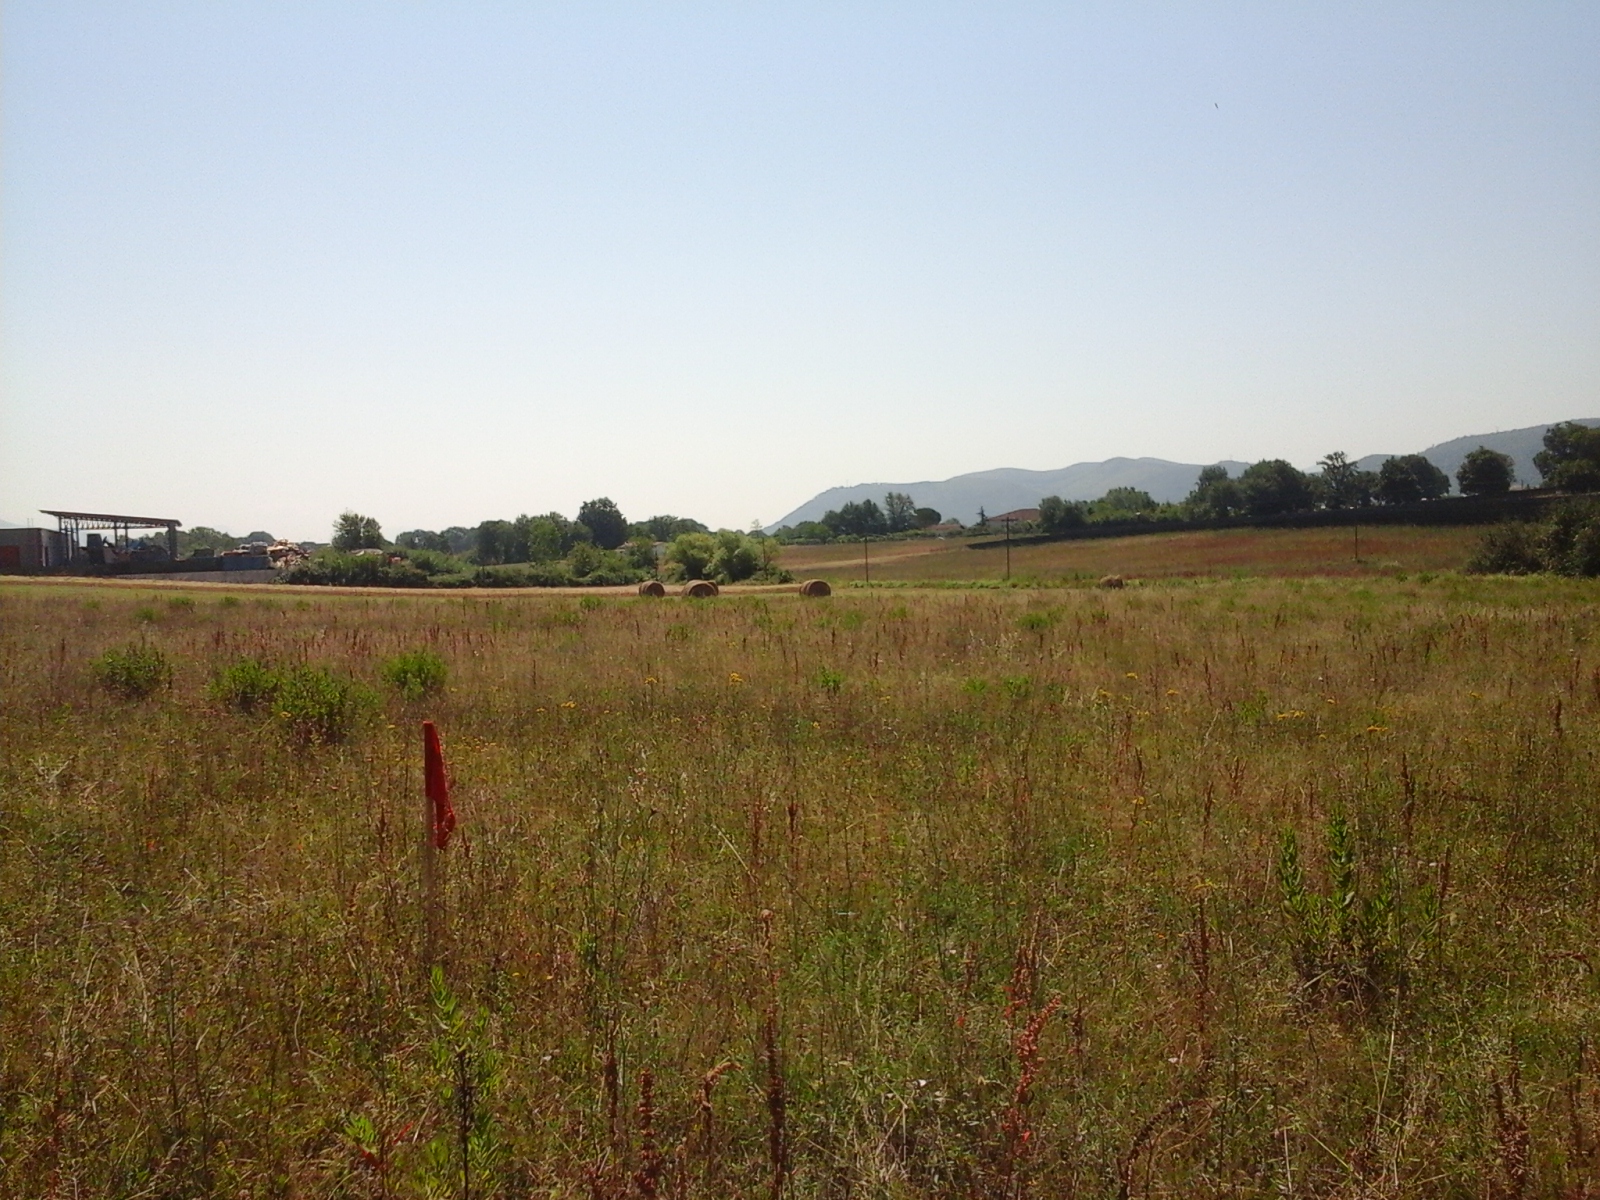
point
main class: Grassland
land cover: Grassland without tree/shrub cover
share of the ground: > 75 %
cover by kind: herbaceous plants 100 %
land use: Agriculture (excluding fallow land and kitchen gardens)
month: June
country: IT
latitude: 41.5455
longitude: 13.4752
